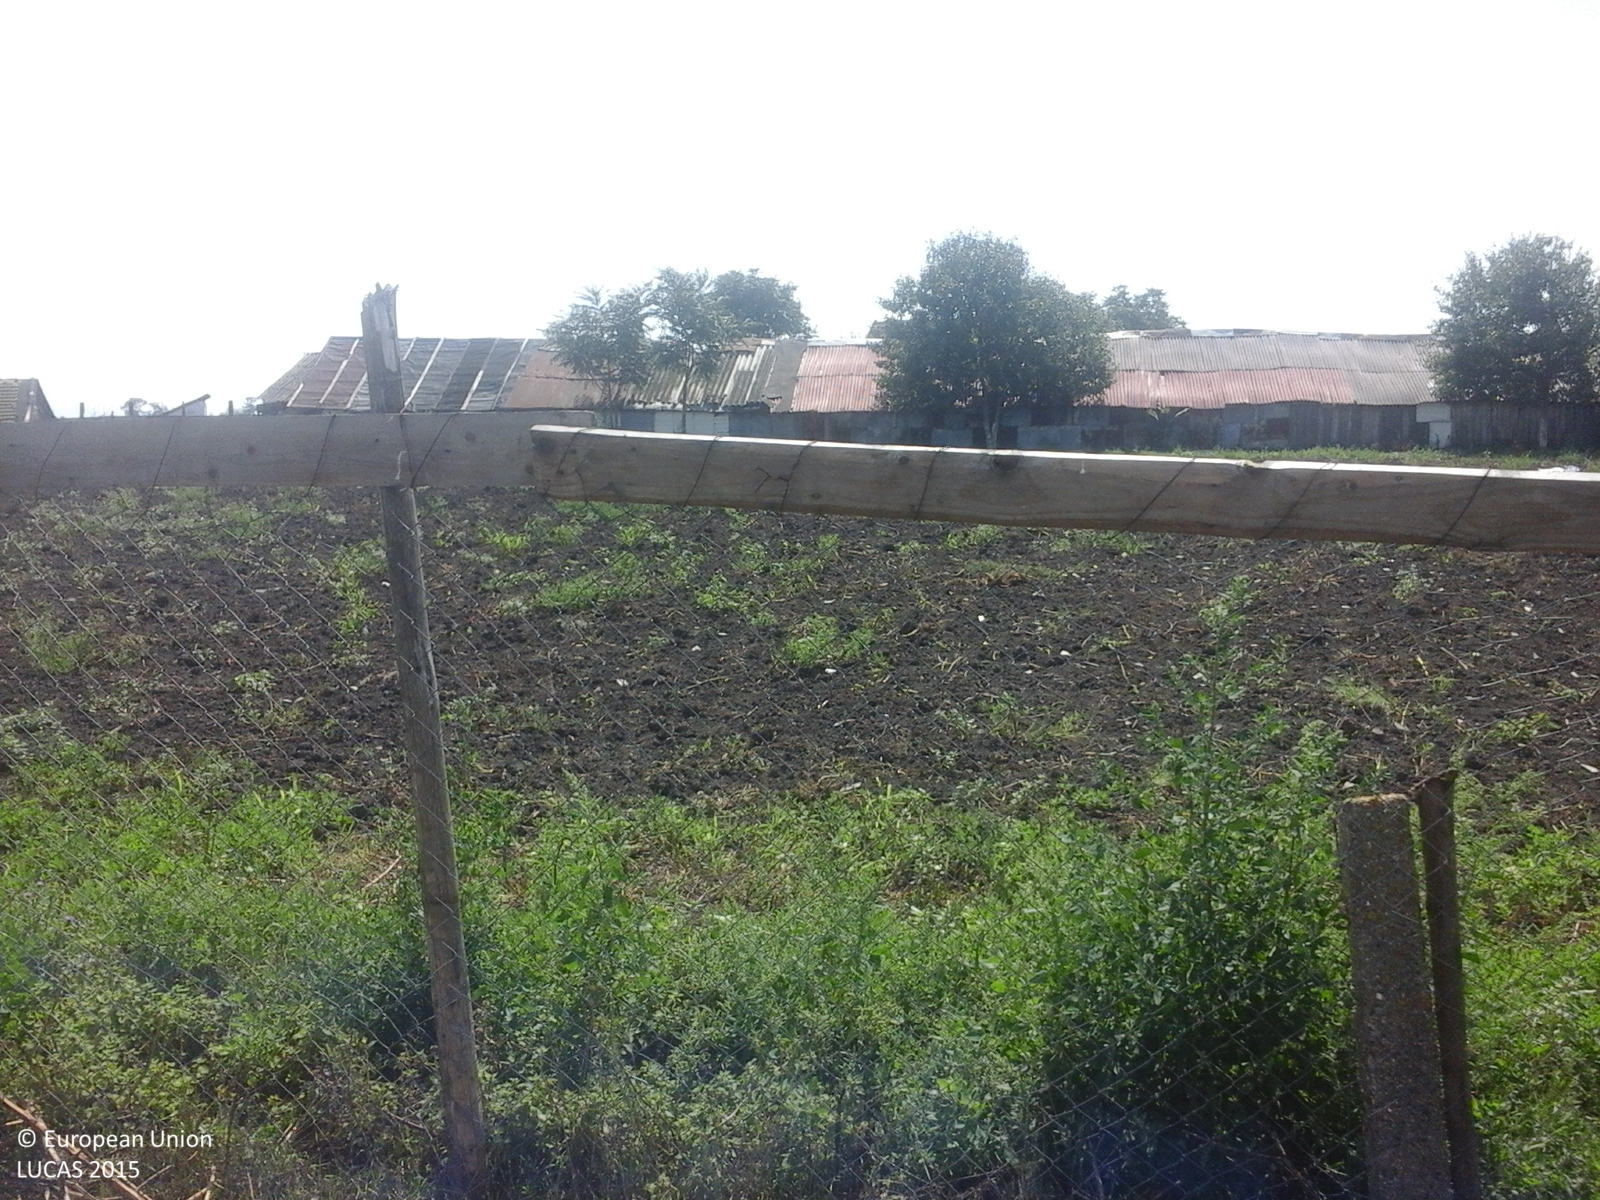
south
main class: Cropland
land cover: Potatoes
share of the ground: > 75 %
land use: Agriculture (excluding fallow land and kitchen gardens)
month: August
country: RO
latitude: 46.4363
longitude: 21.3457
